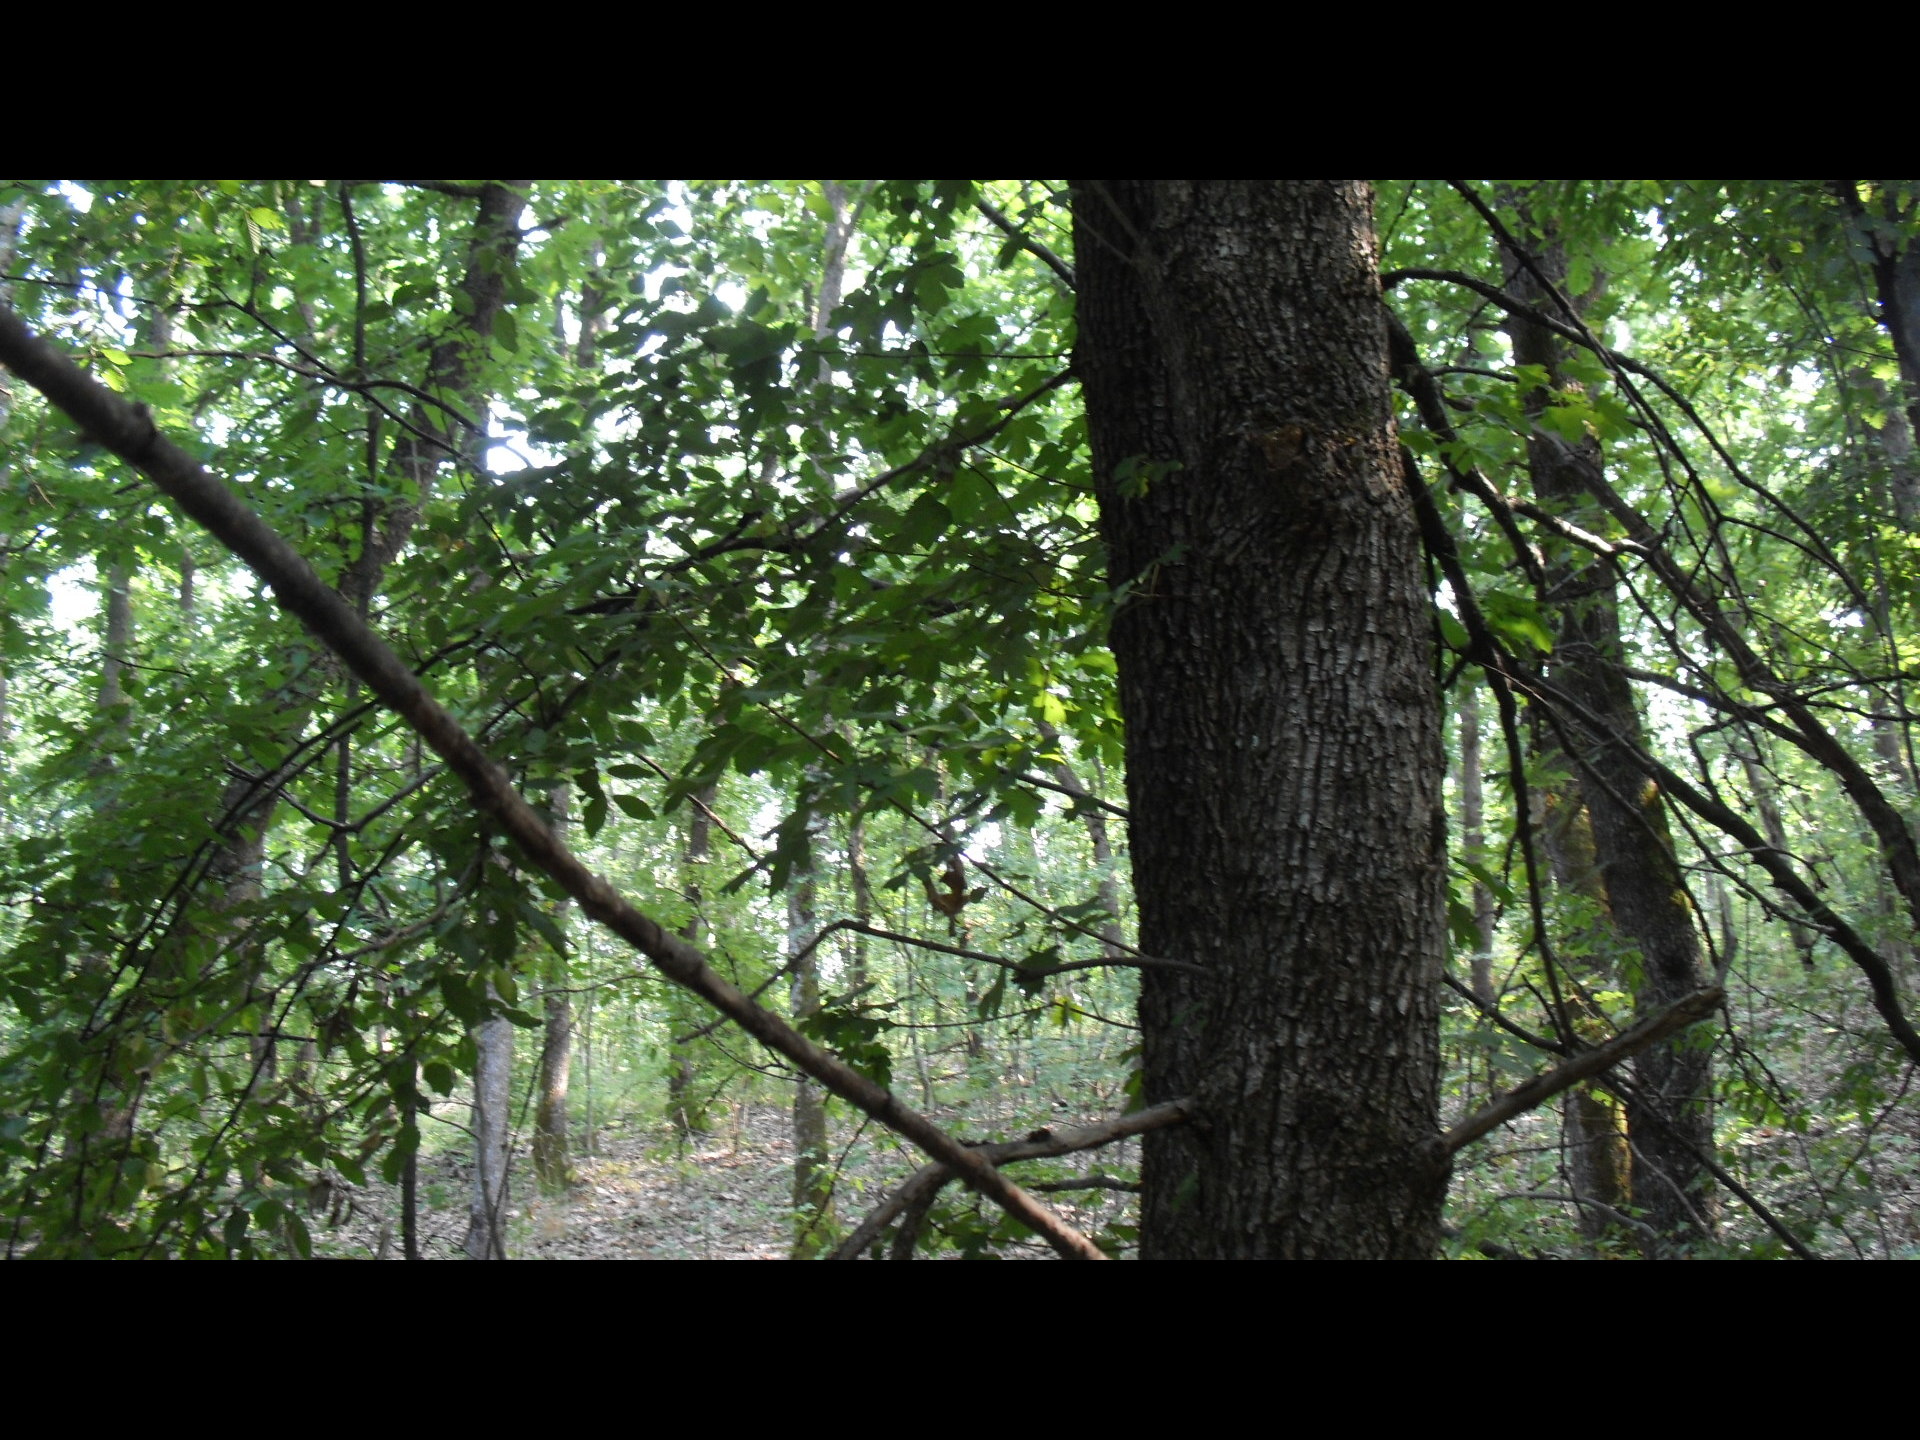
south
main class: Woodland
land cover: Broadleaved woodland
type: mesophytic deciduous forest
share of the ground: > 75 %
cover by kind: broadleaved forest trees 95 %, shrubs 5 %
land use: Forestry
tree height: > 5 m
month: July
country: BG
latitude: 43.6941
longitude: 22.7025
